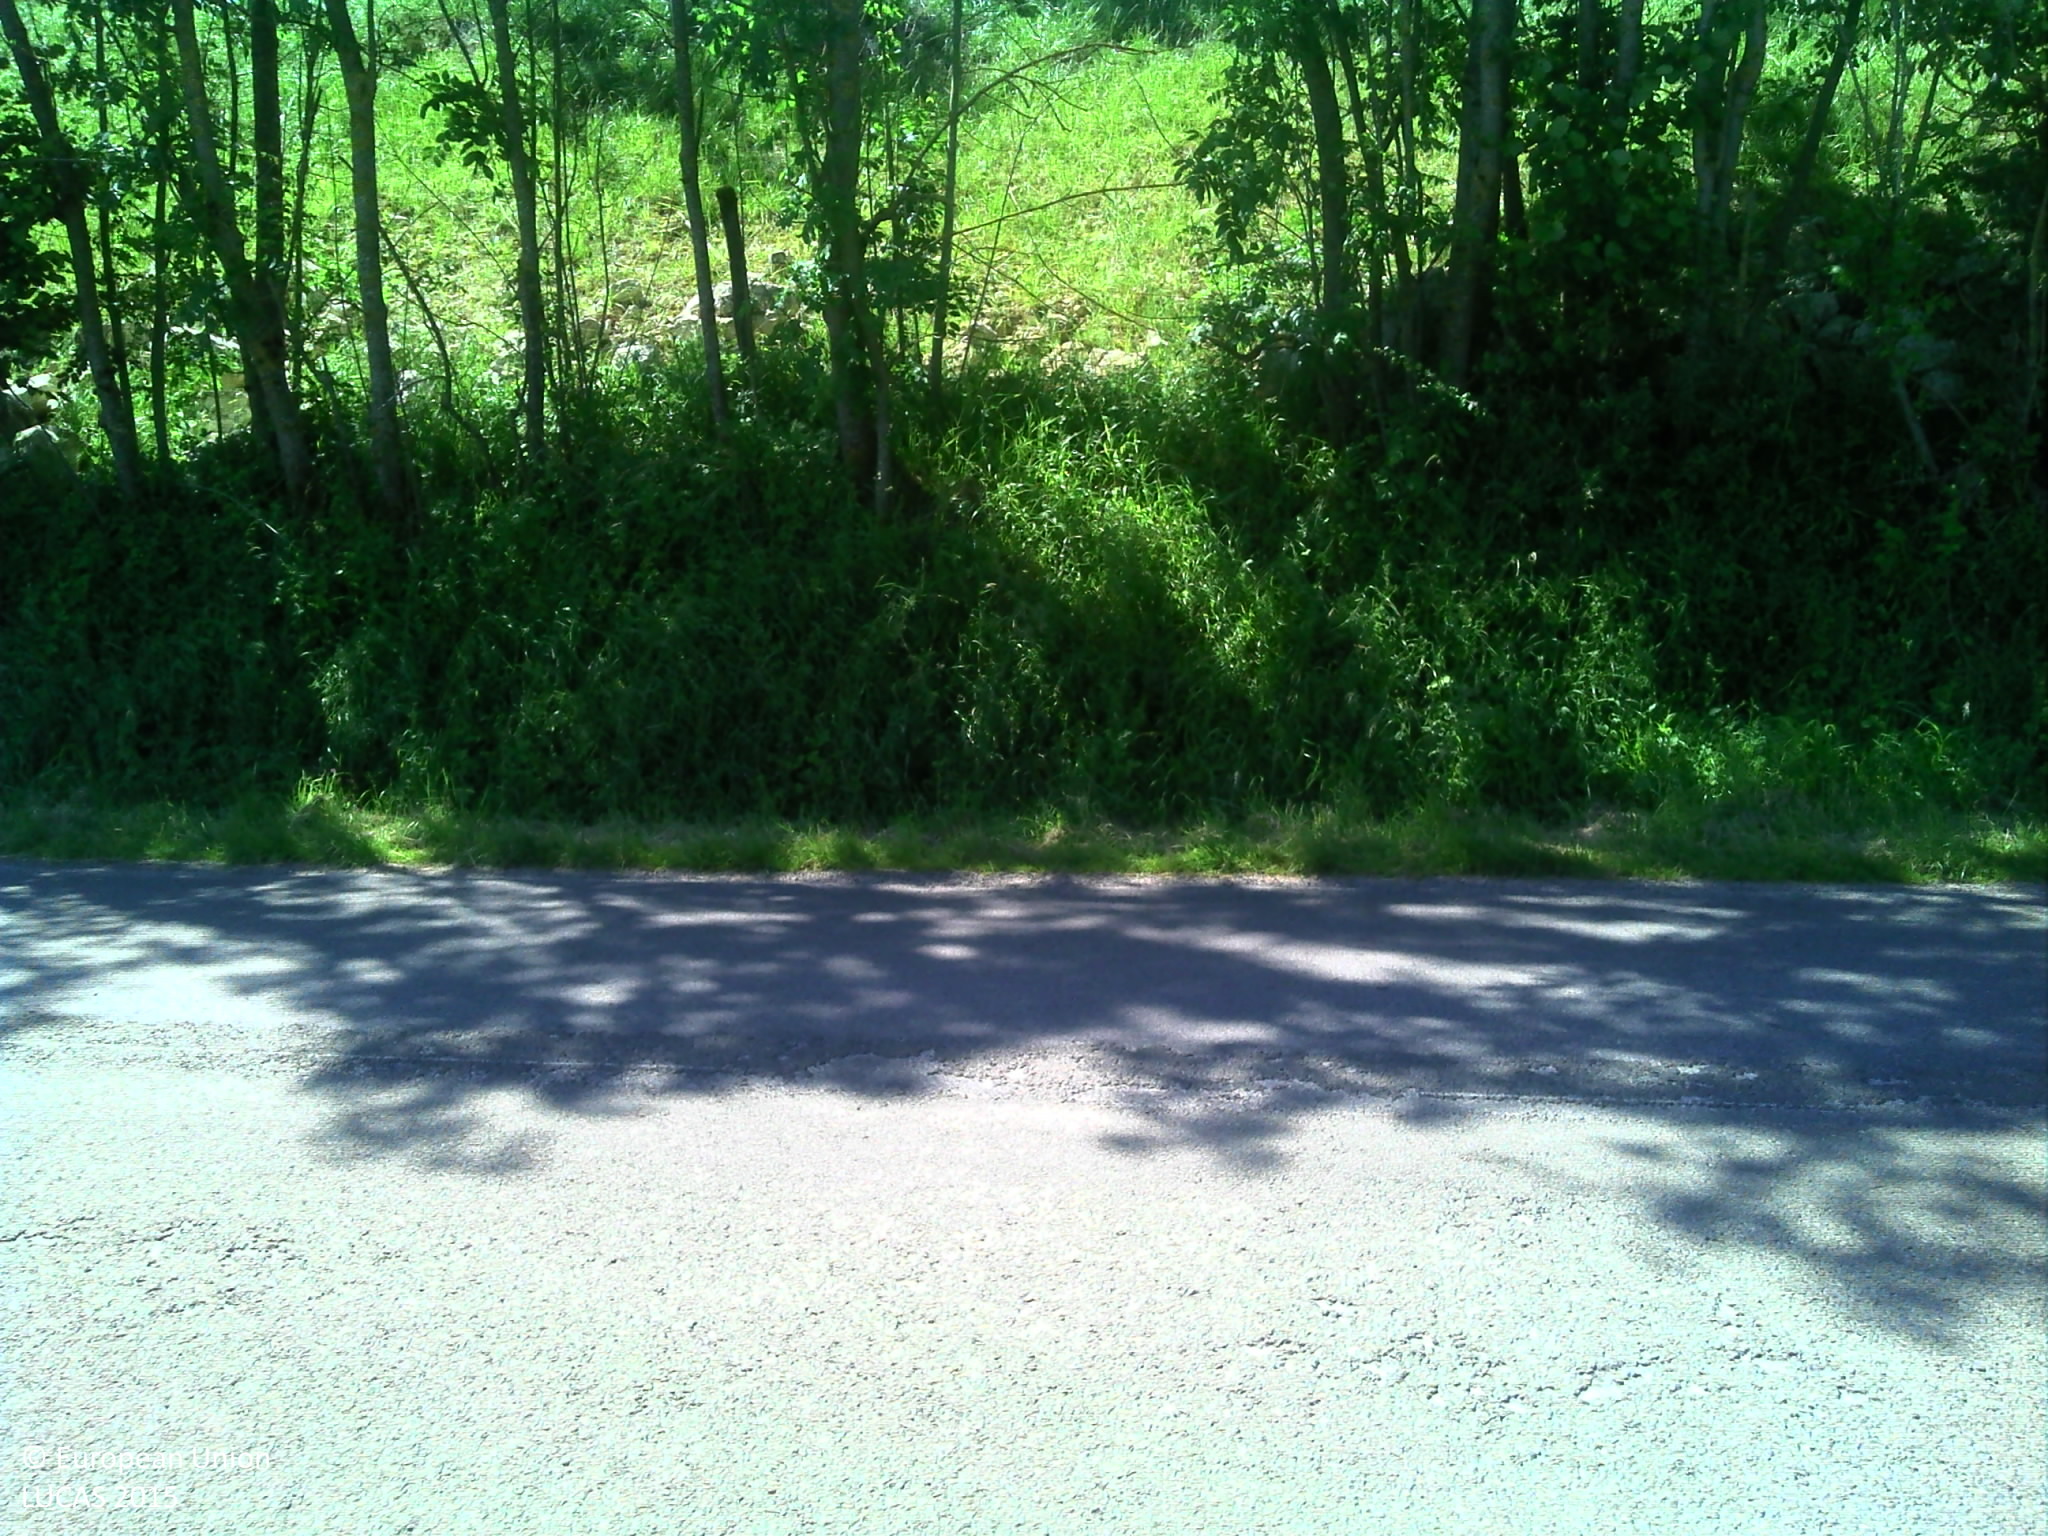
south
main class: Grassland
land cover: Grassland without tree/shrub cover
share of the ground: > 75 %
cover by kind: herbaceous plants 100 %
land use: Agriculture (excluding fallow land and kitchen gardens)
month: June
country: FR
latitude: 49.6697
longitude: 4.0783
